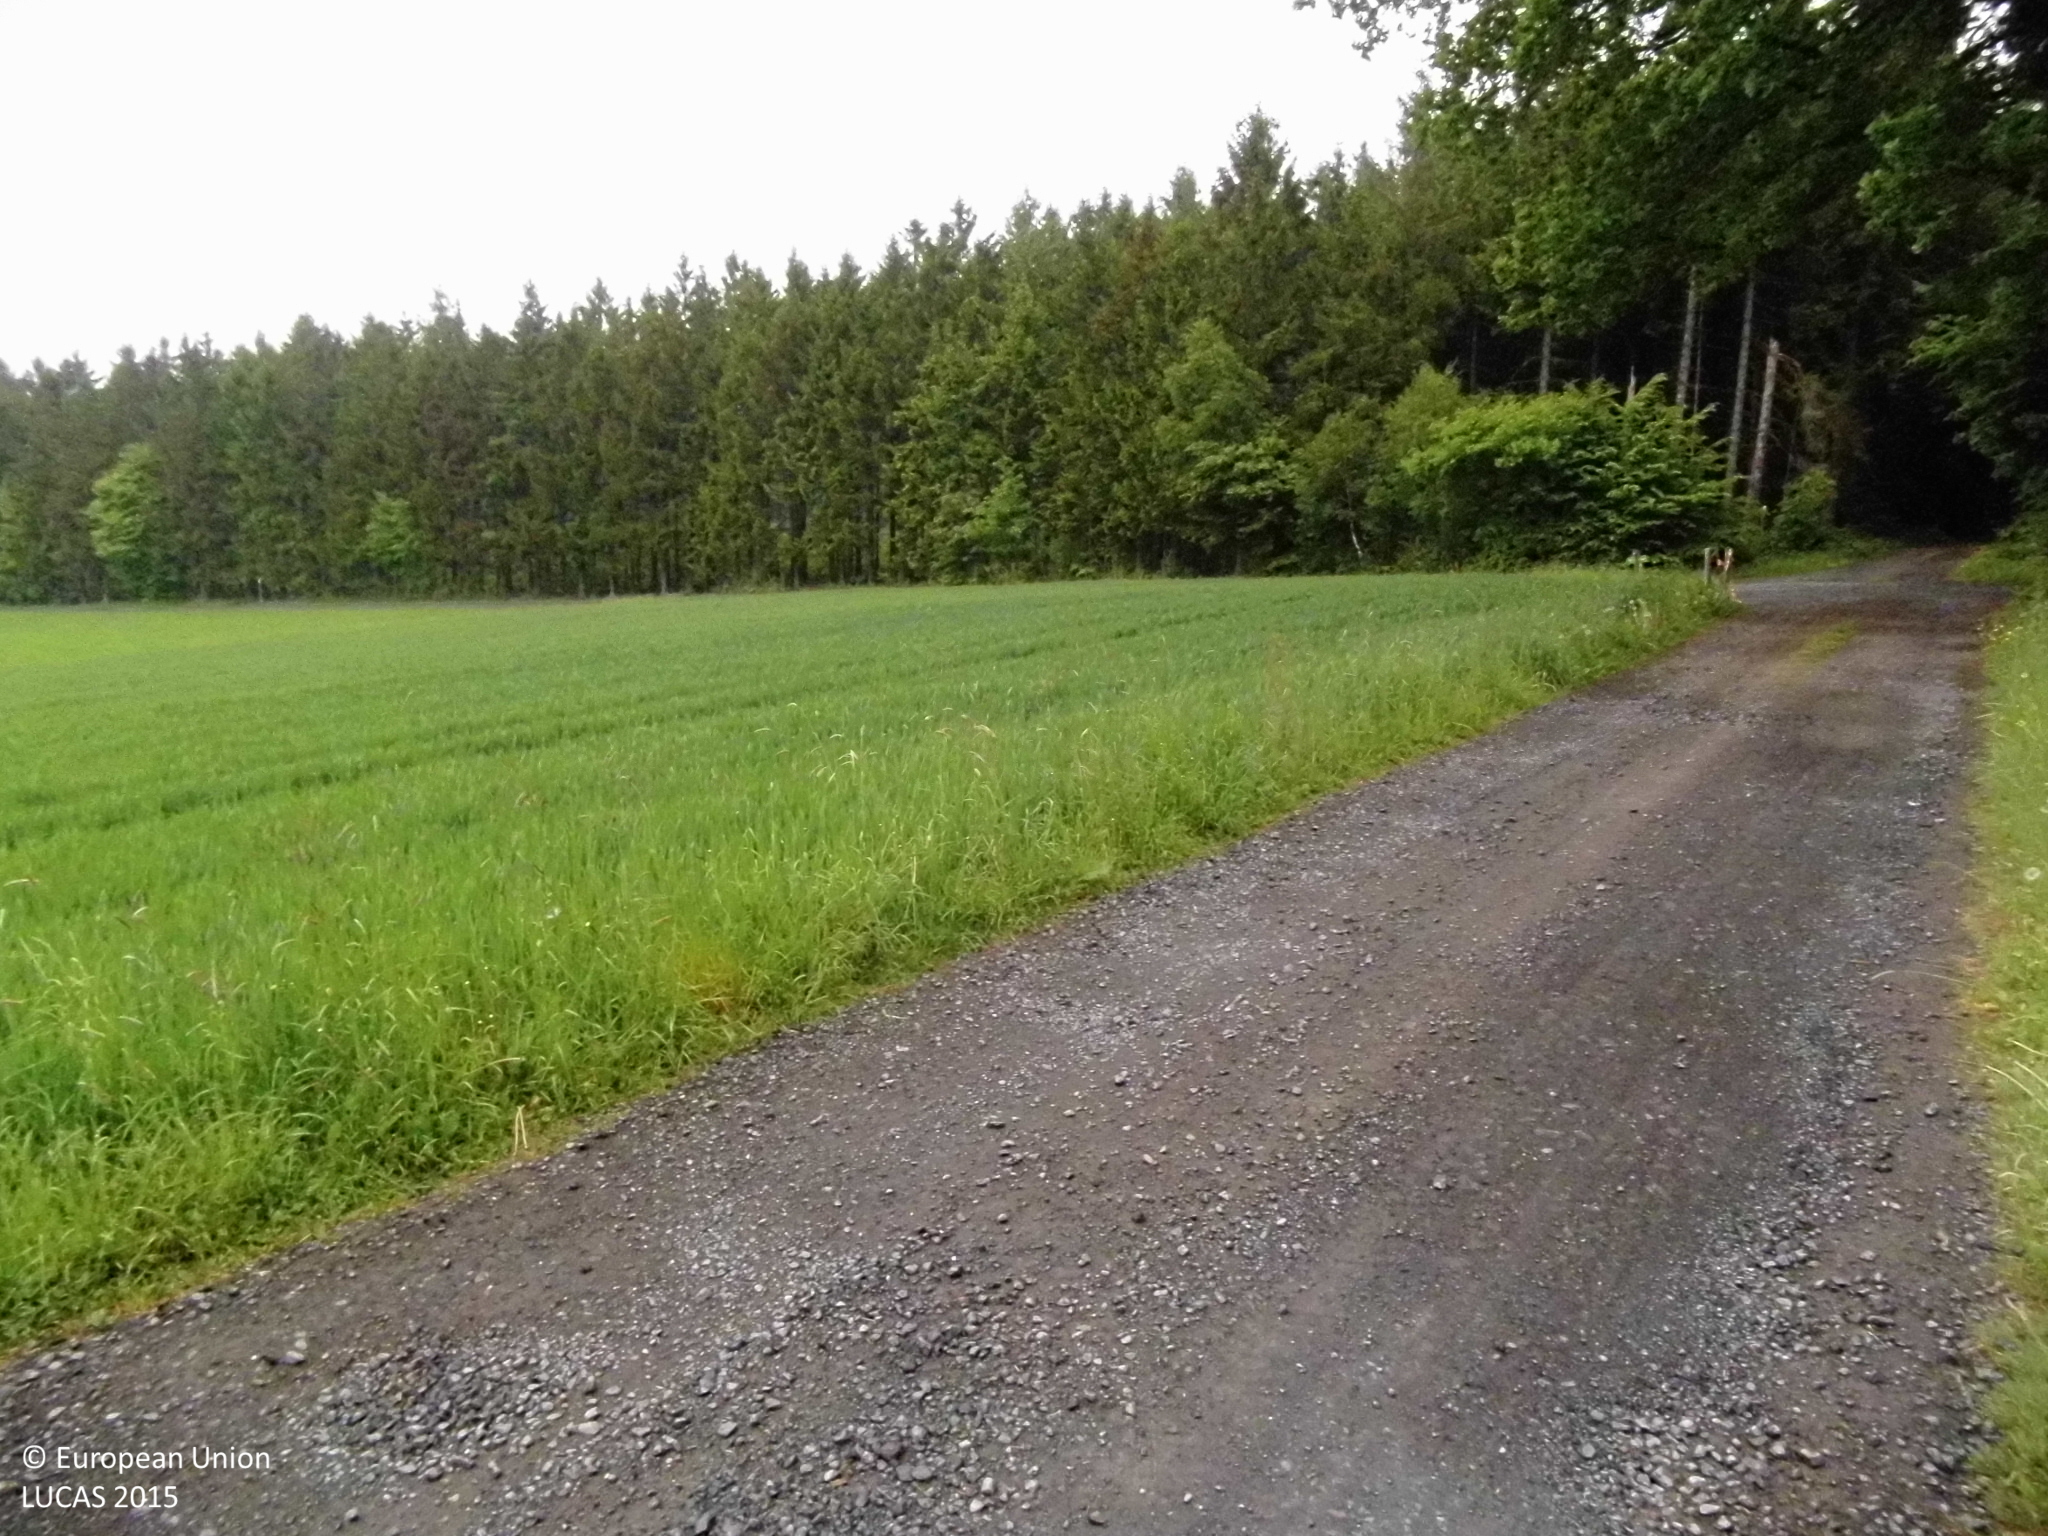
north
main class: Grassland
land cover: Grassland without tree/shrub cover
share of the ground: > 75 %
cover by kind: herbaceous plants 100 %
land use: Agriculture (excluding fallow land and kitchen gardens)
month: May
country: DE
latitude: 50.6605
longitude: 7.4963
